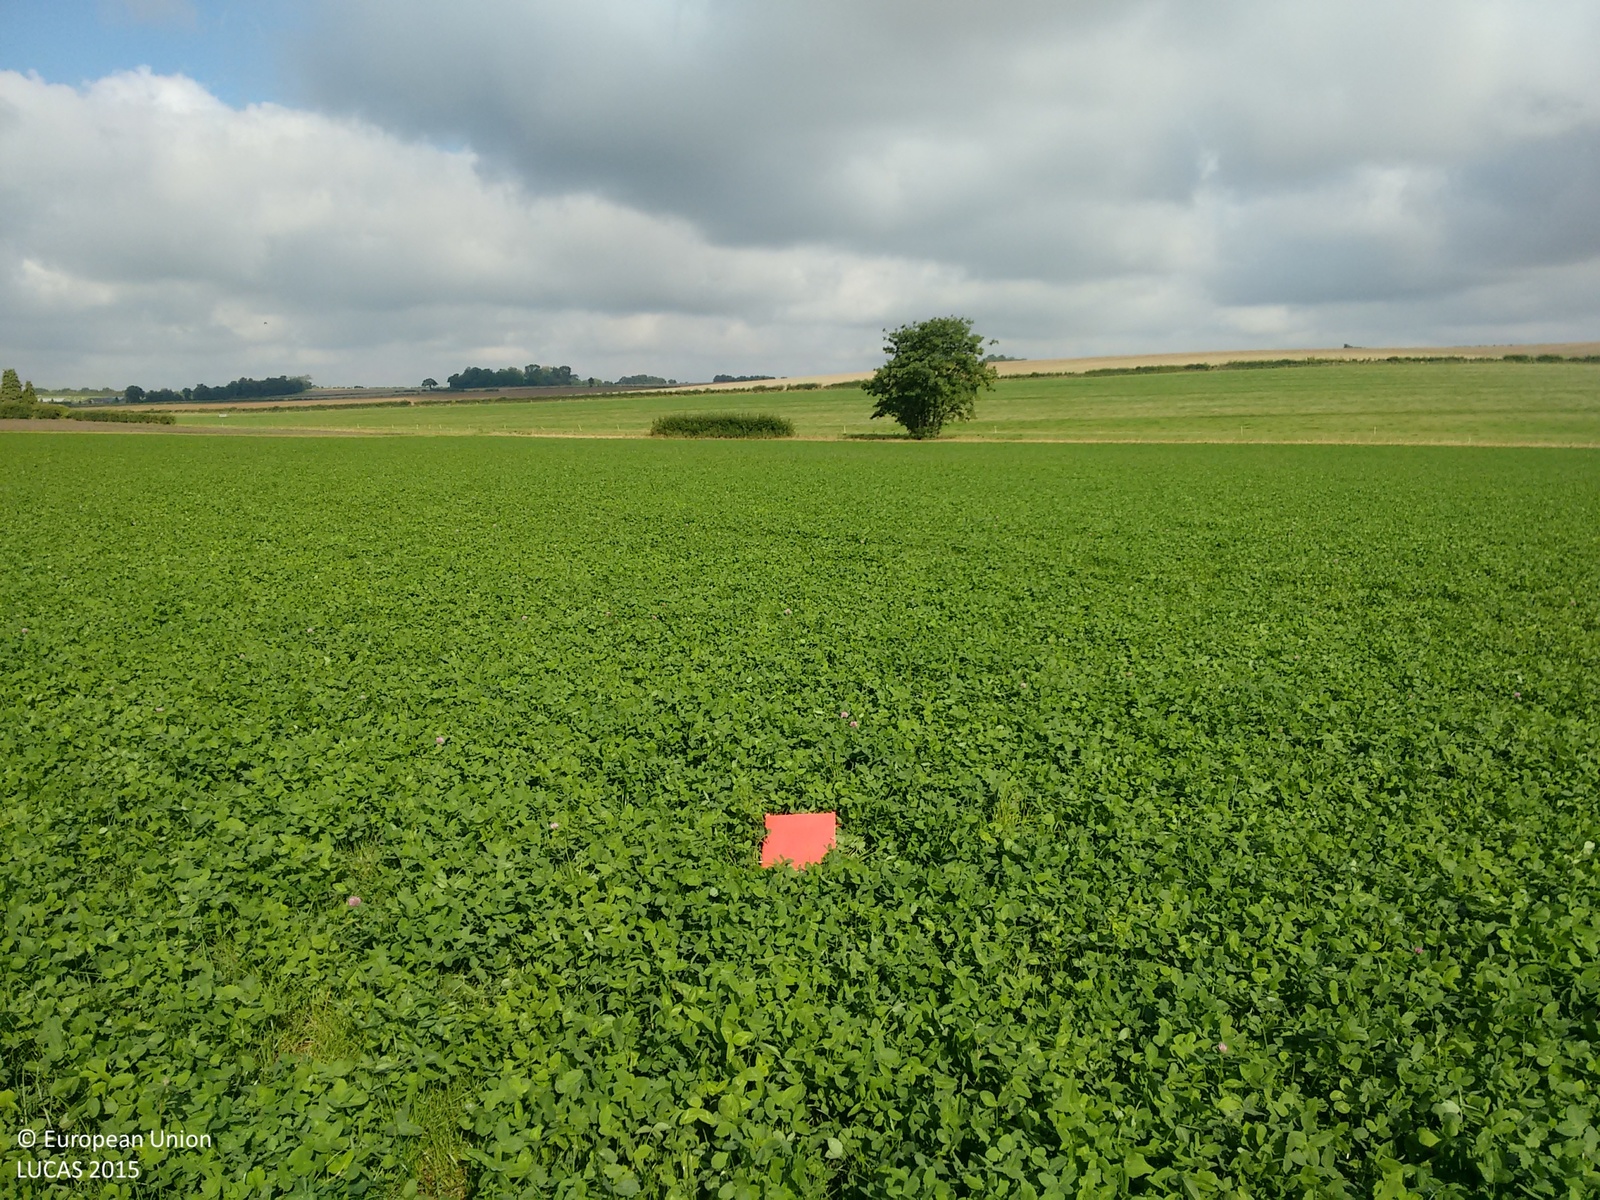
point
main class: Cropland
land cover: Clovers
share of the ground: > 75 %
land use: Agriculture (excluding fallow land and kitchen gardens)
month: September
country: GB
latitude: 52.2132
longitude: 0.5031
